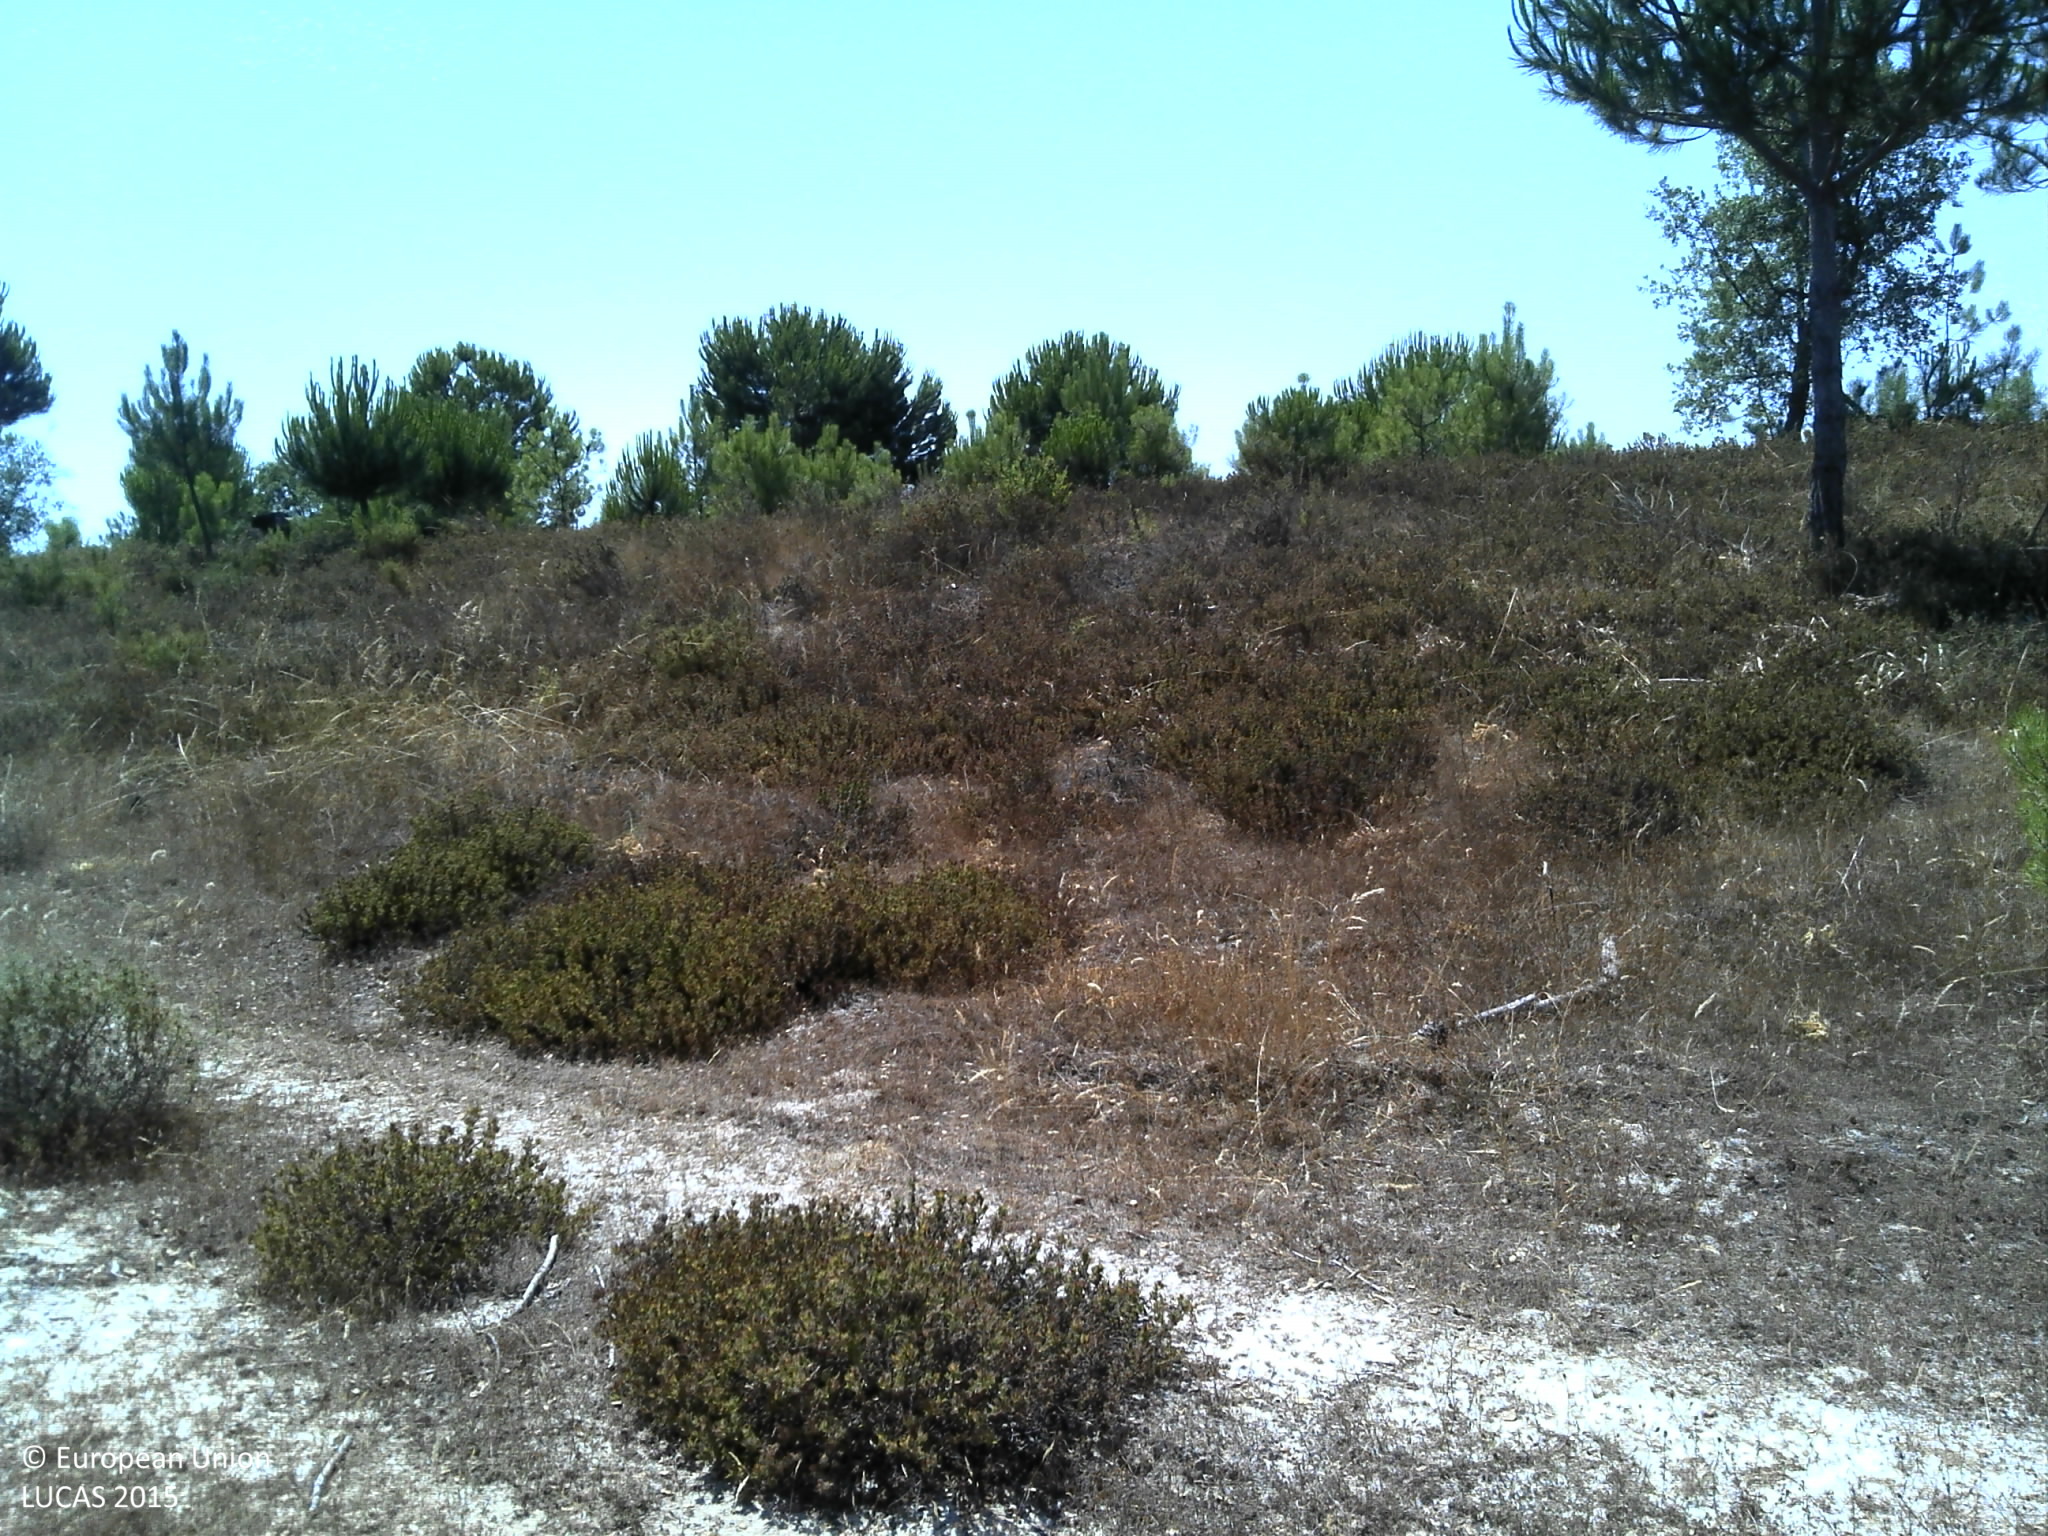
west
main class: Grassland
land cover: Grassland with sparse tree/shrub cover
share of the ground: 25 - 50 %
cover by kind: unconsolidated bare surface 60 %, herbaceous plants 35 %, coniferous forest trees 5 %
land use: Forestry
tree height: > 5 m
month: June
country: PT
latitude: 38.5812
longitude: -9.0685
